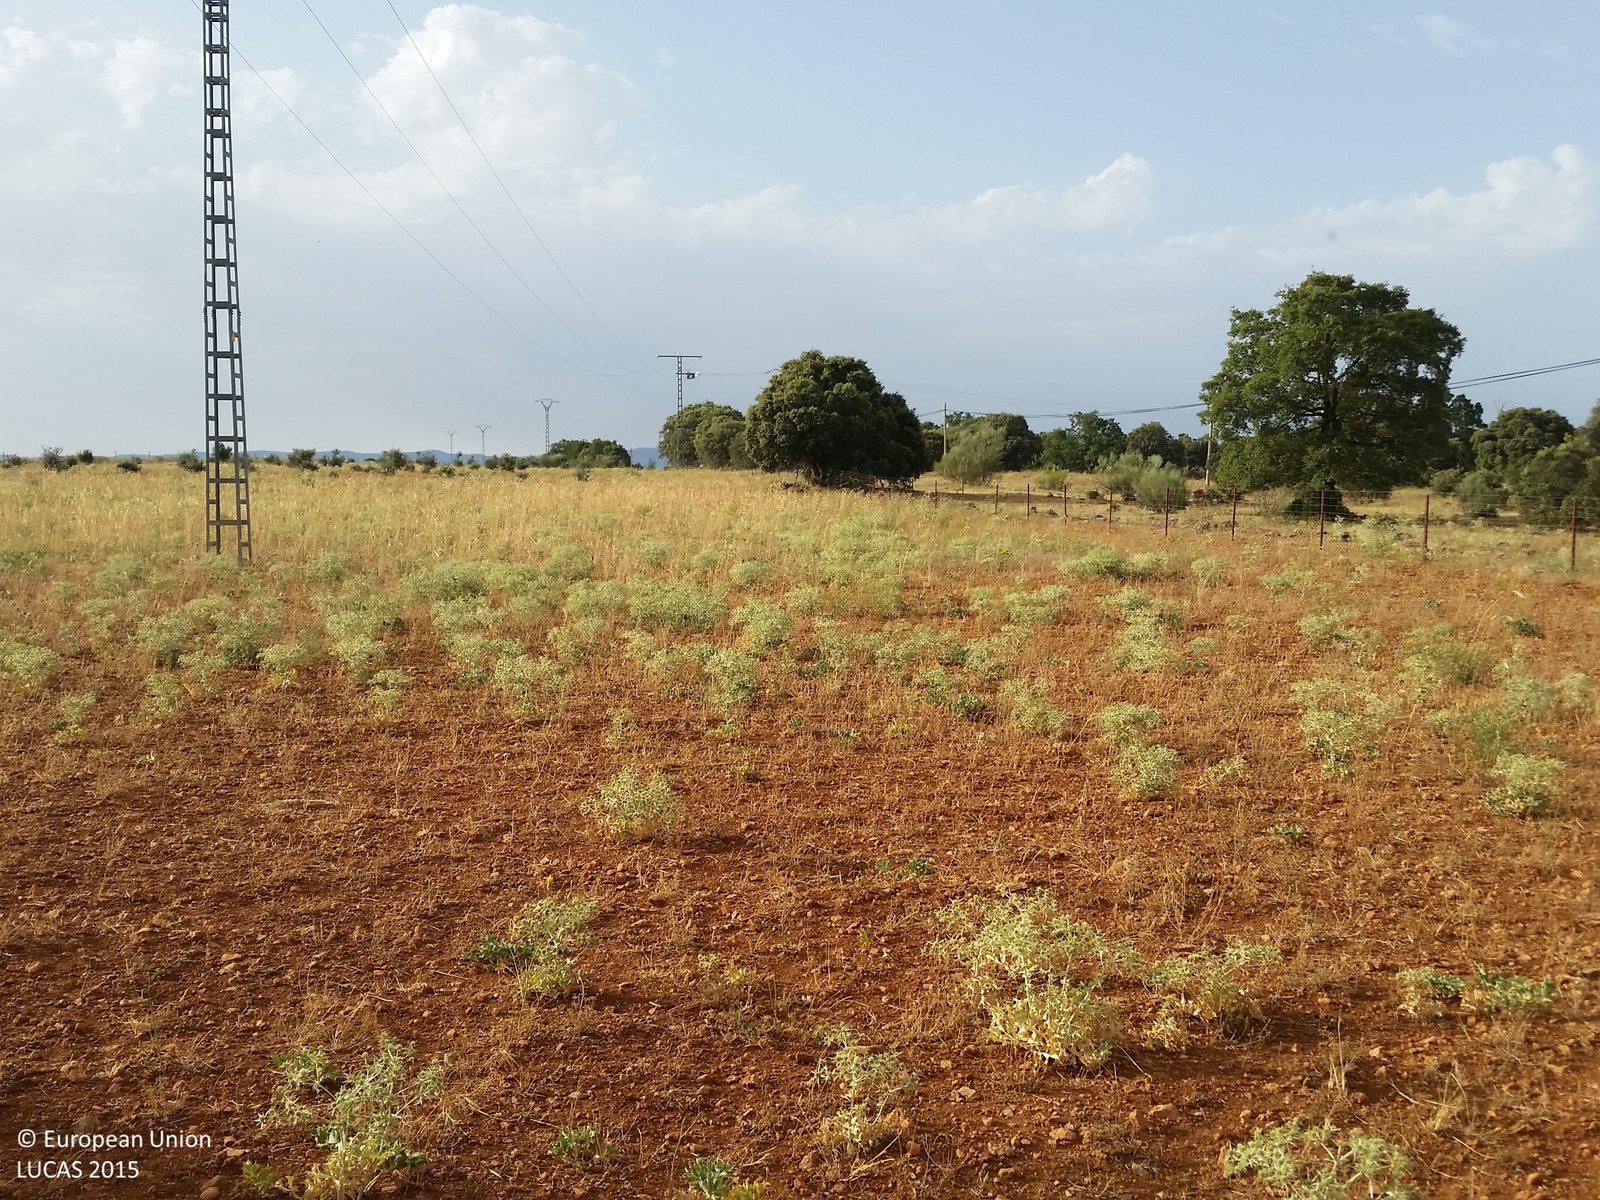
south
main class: Woodland
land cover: Broadleaved woodland
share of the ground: 50 - 75 %
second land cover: Spontaneously vegetated surfaces
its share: 25 - 50 %
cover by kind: broadleaved forest trees 60 %, herbaceous plants 30 %, unconsolidated bare surface 10 %
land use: Forestry
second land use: Fallow land
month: July
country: ES
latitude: 38.7438
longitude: -2.5550
